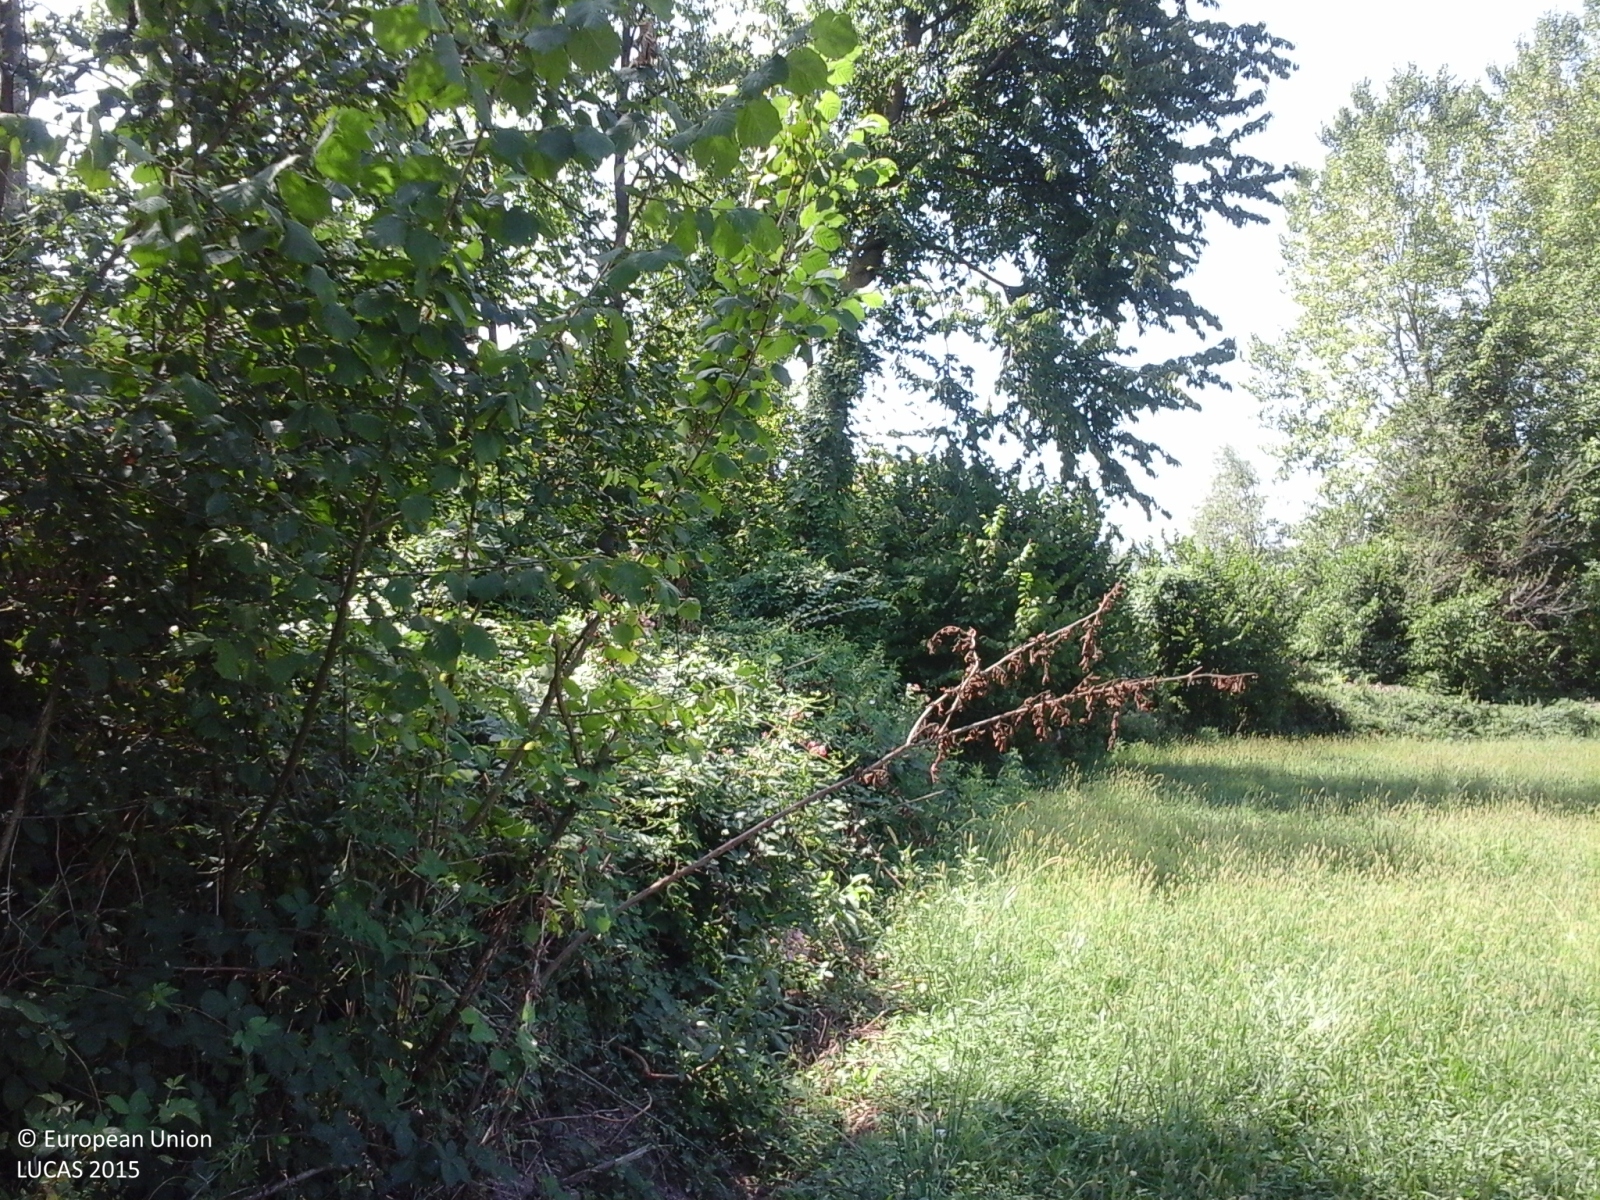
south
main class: Woodland
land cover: Broadleaved woodland
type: thermophilous deciduous forest
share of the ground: > 75 %
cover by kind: broadleaved forest trees 80 %, shrubs 20 %
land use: Semi-natural and natural areas not in use
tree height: > 5 m
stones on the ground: < 10 %
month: August
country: IT
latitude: 44.3450
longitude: 7.7845
